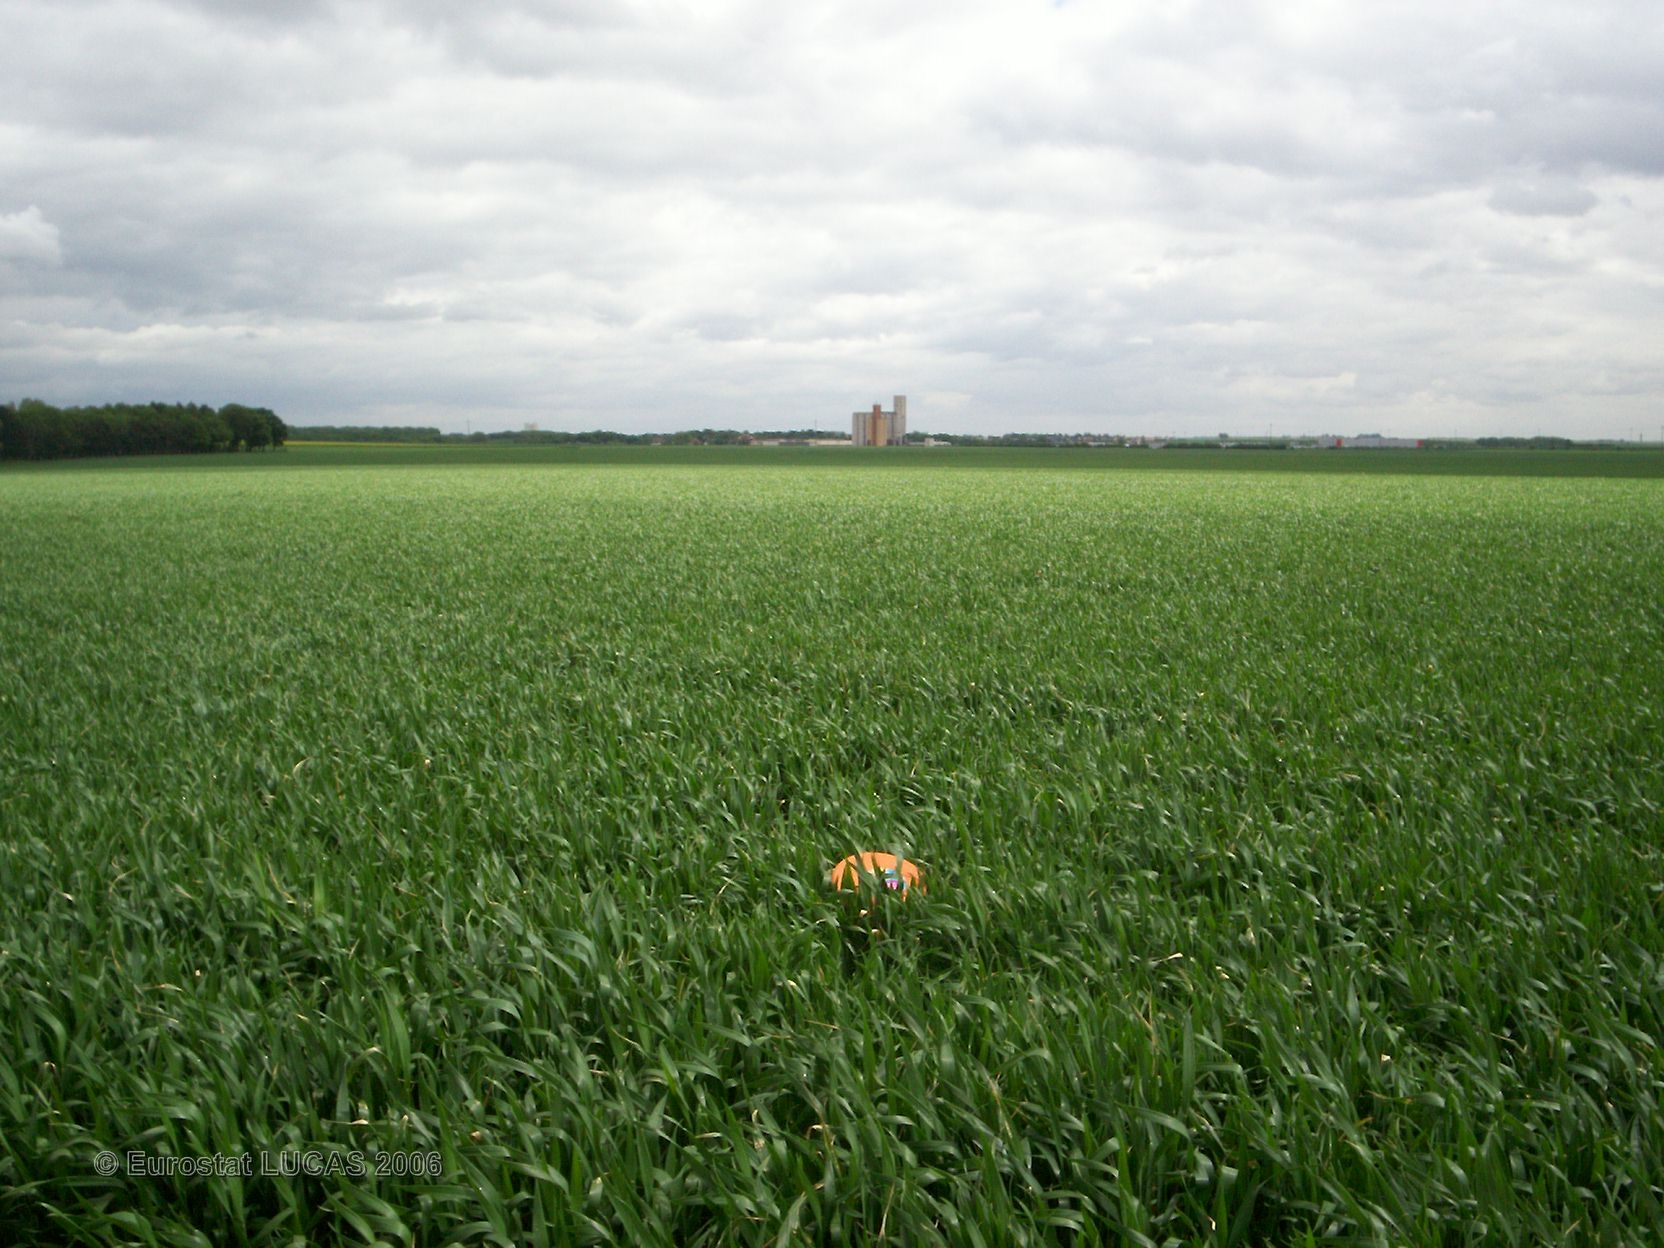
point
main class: Cropland
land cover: Common wheat
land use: Agriculture (excluding fallow land and kitchen gardens)
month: May
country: FR
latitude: 49.1417
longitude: 2.7657
